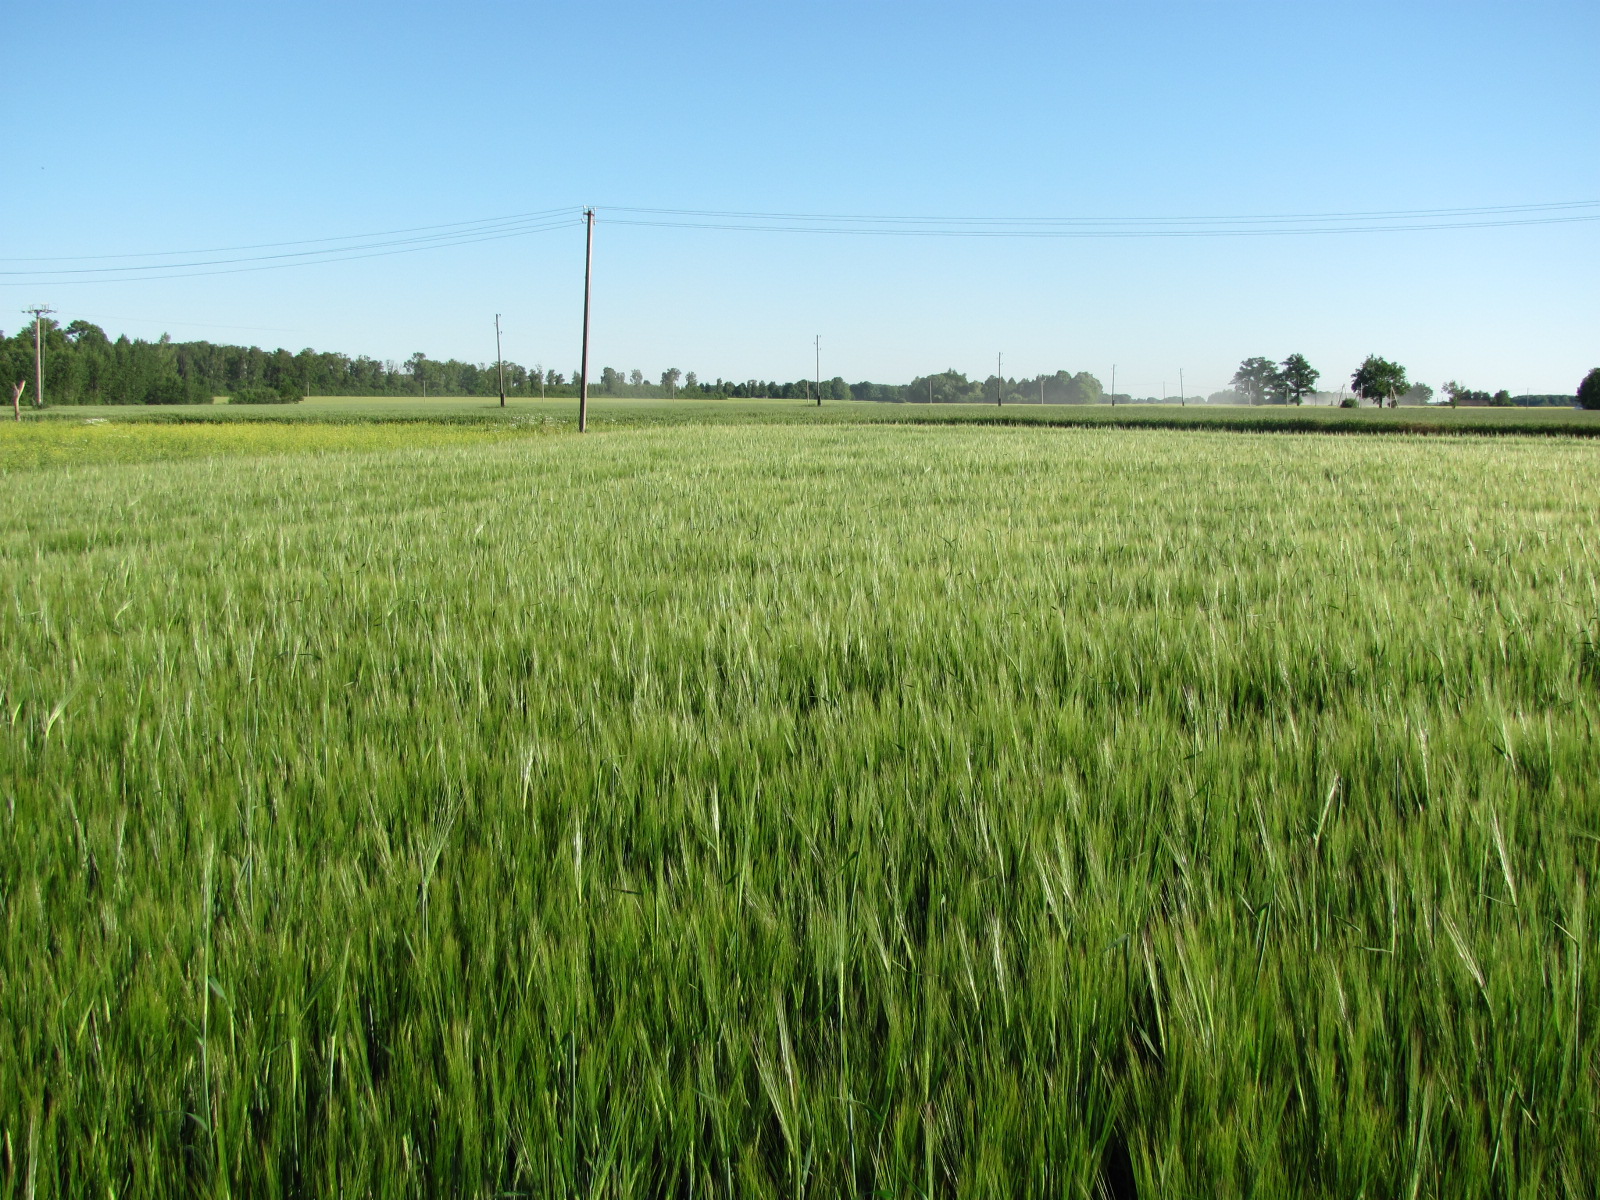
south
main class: Cropland
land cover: Barley
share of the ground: > 75 %
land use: Agriculture (excluding fallow land and kitchen gardens)
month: July
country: LV
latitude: 56.4192
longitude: 23.8453
